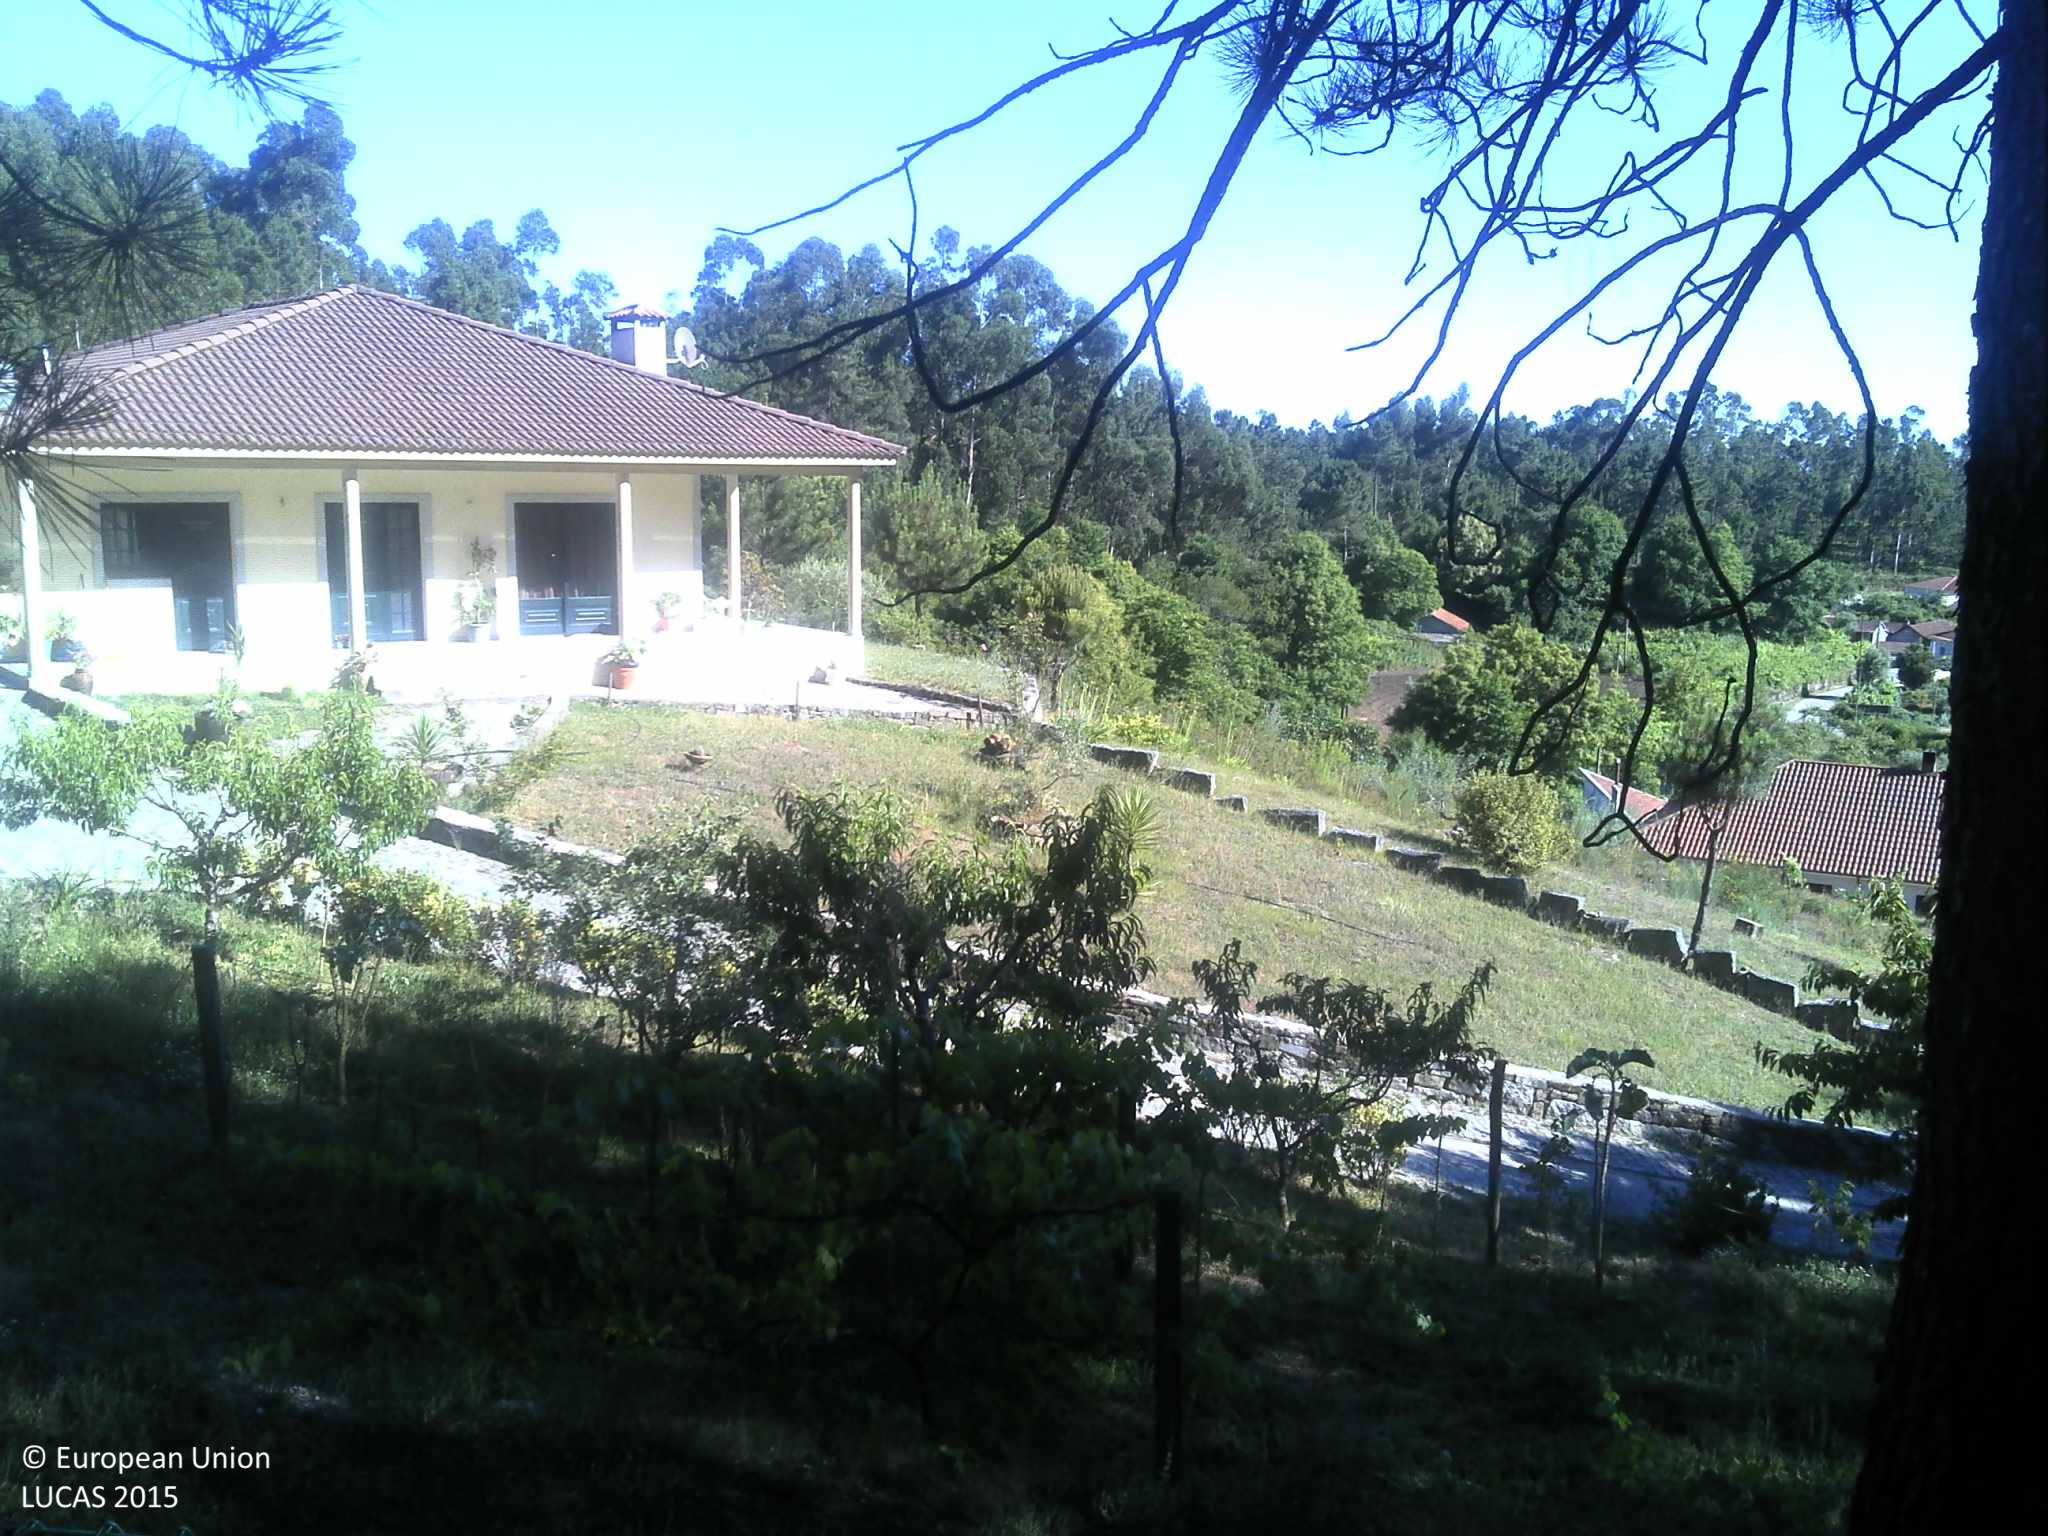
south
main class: Woodland
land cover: Pine dominated coniferous woodland
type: coniferous forest of the mediterranean region
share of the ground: 50 - 75 %
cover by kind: coniferous forest trees 70 %, shrubs 15 %, unconsolidated bare surface 10 %, herbaceous plants 5 %
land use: Forestry
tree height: > 5 m
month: June
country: PT
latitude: 41.3698
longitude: -8.1356
